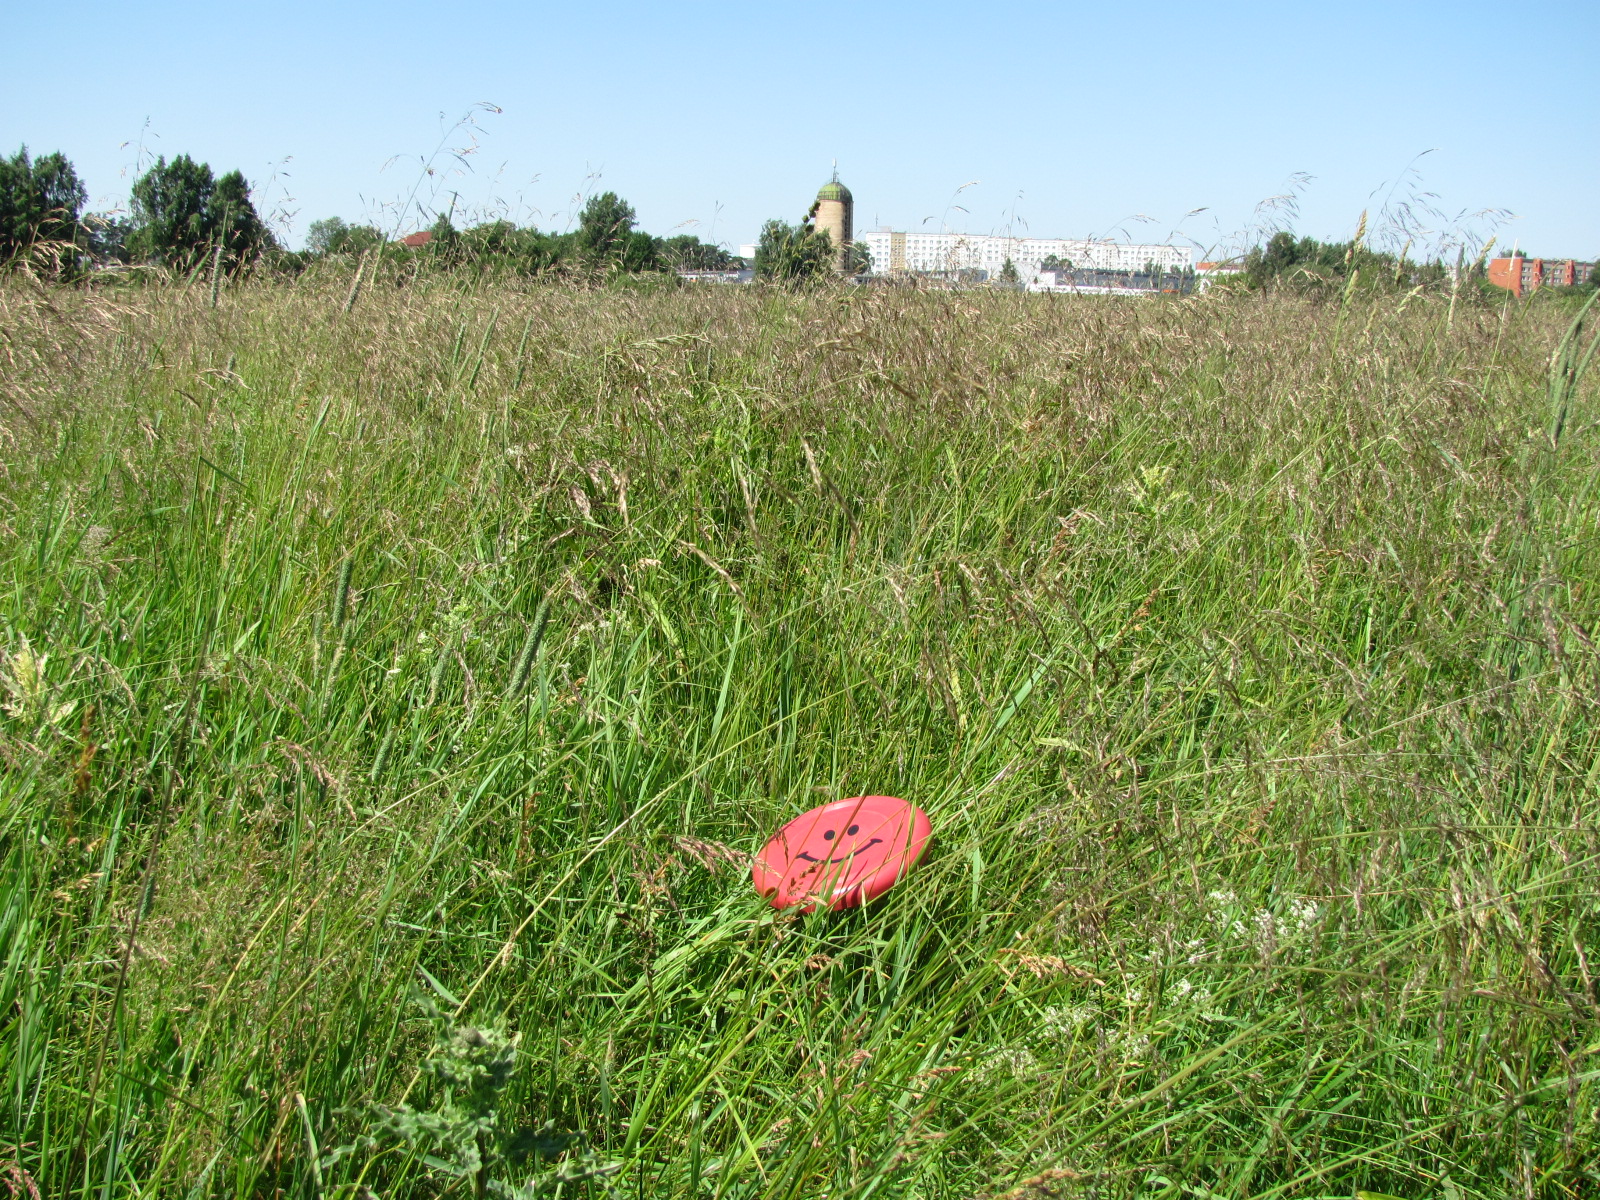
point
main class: Grassland
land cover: Grassland without tree/shrub cover
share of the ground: > 75 %
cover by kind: herbaceous plants 100 %
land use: Agriculture (excluding fallow land and kitchen gardens)
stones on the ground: < 10 %
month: July
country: LV
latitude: 56.8974
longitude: 24.1564
